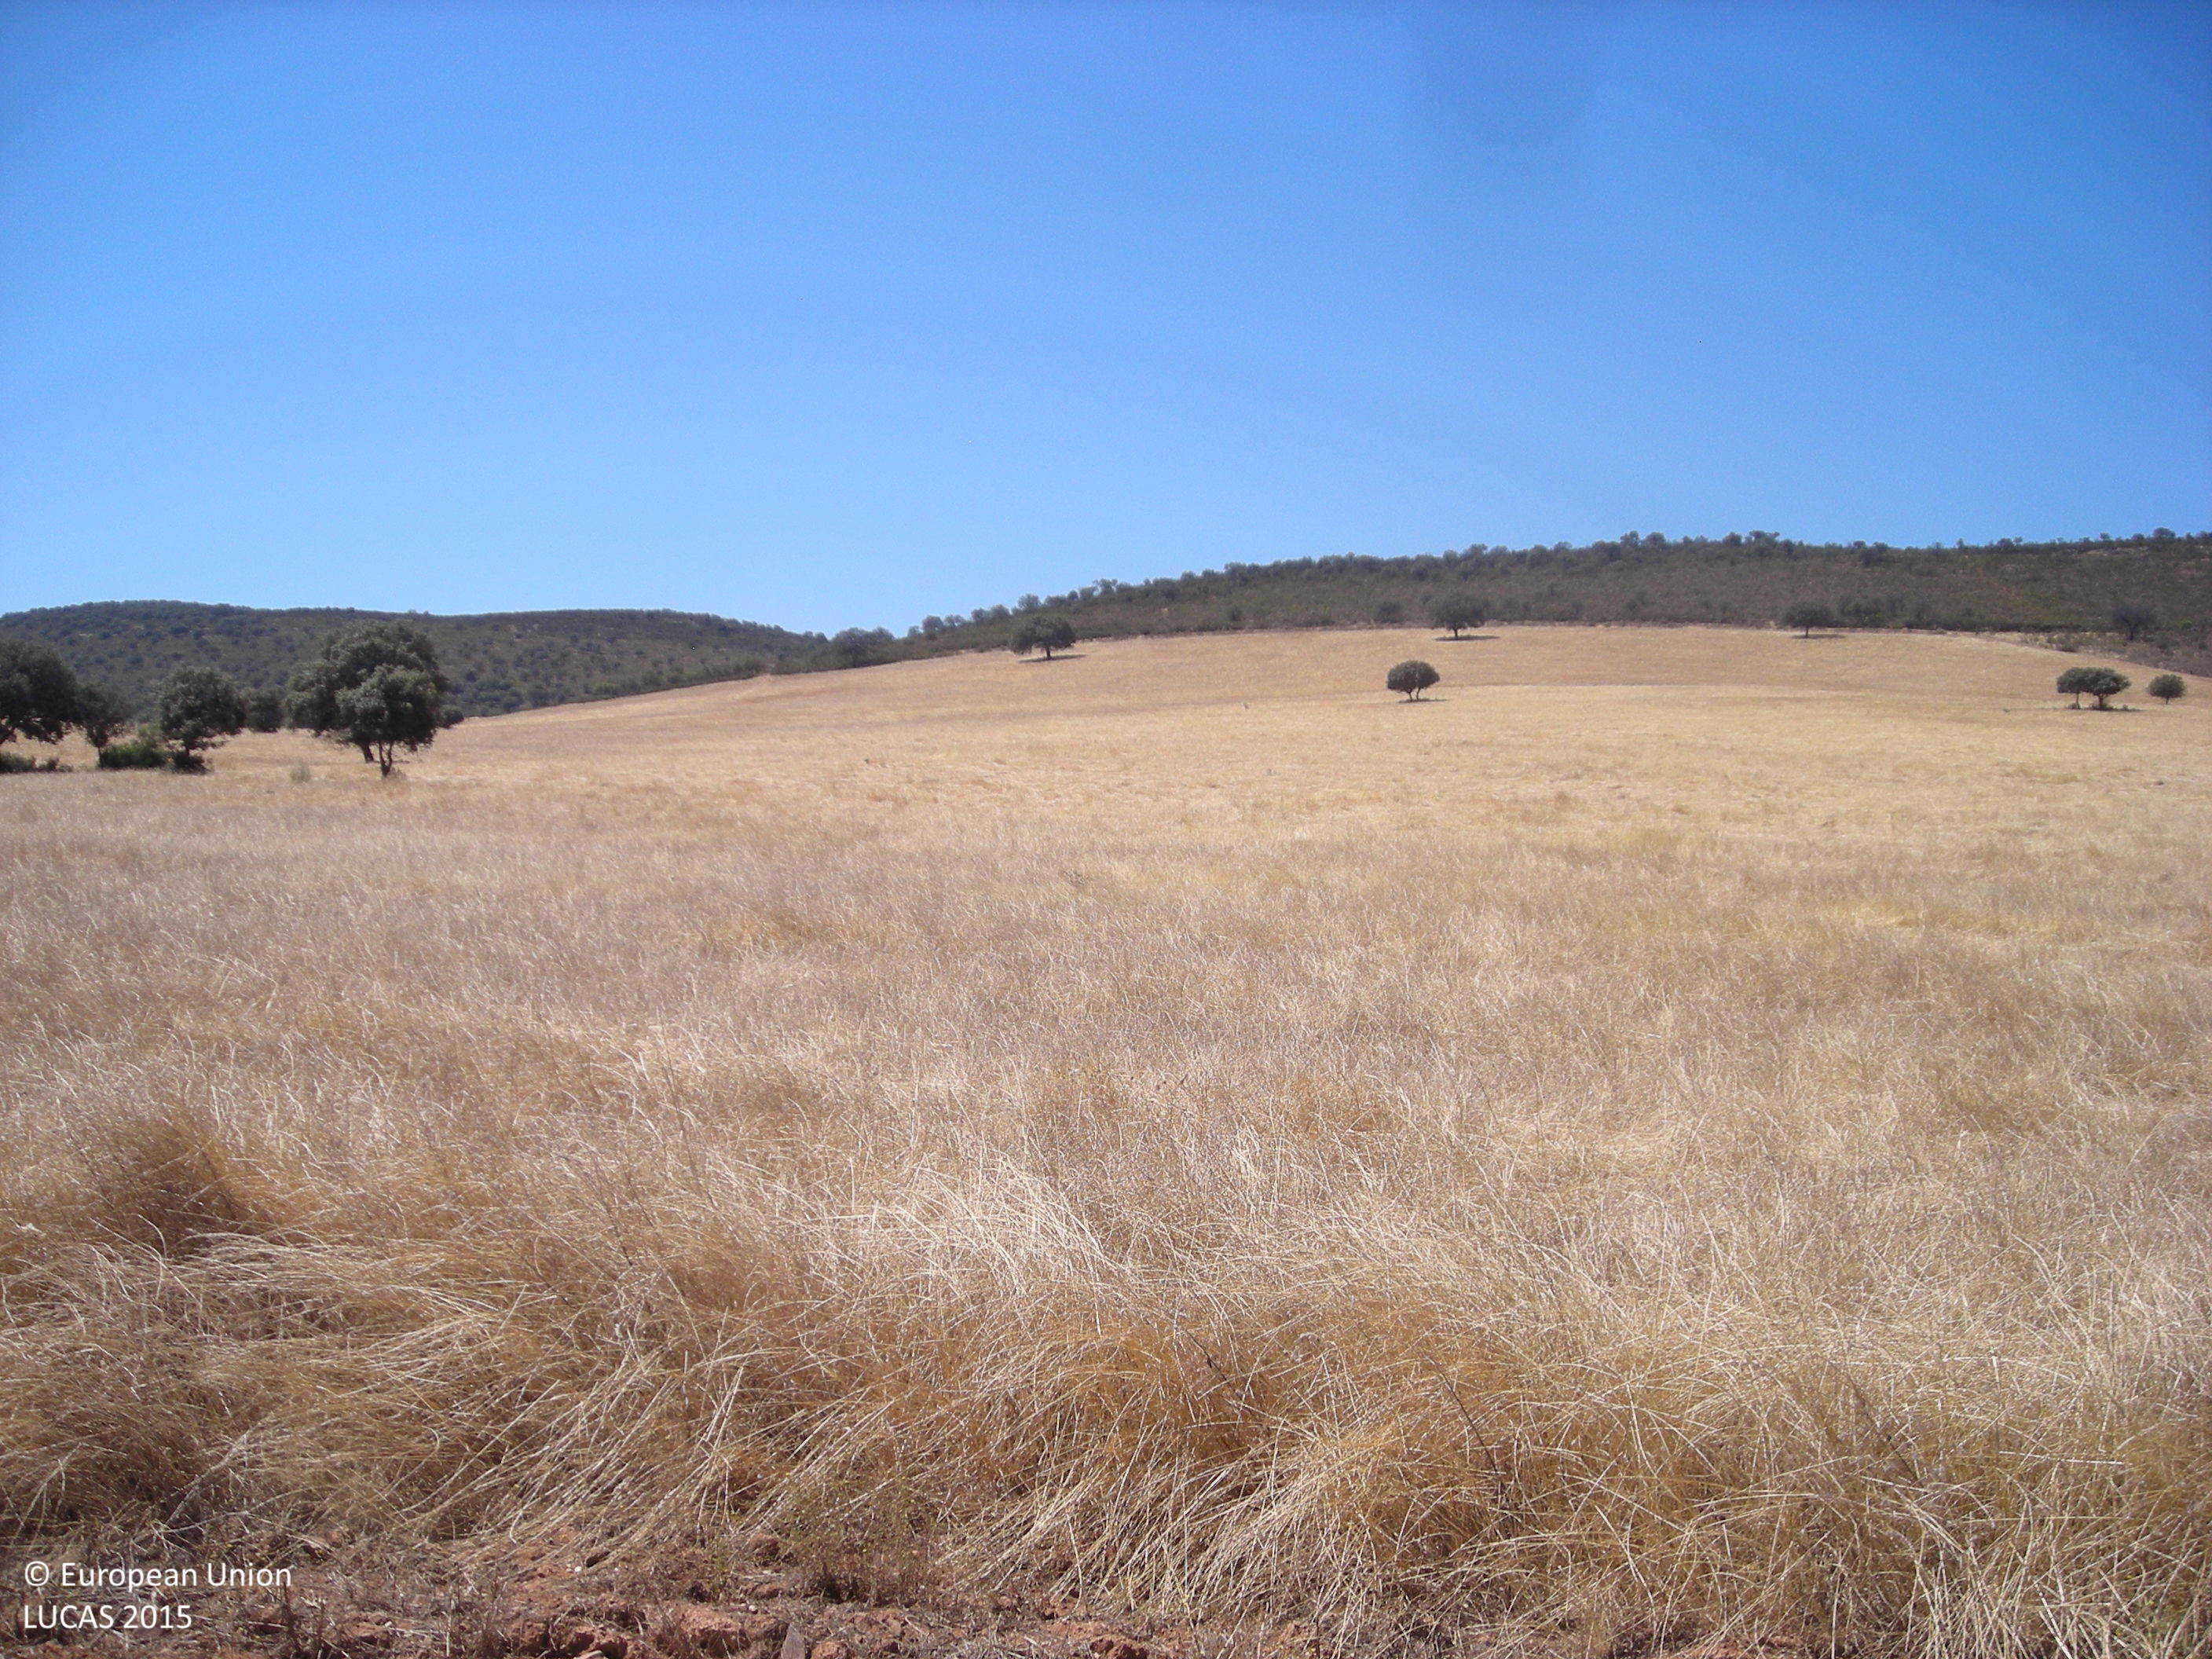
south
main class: Woodland
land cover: Broadleaved woodland
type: broadleaved evergreen forest
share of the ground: 25 - 50 %
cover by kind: broadleaved forest trees 40 %, shrubs 30 %, herbaceous plants 30 %
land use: Forestry
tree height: > 5 m
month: July
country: ES
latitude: 38.7638
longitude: -5.8704
